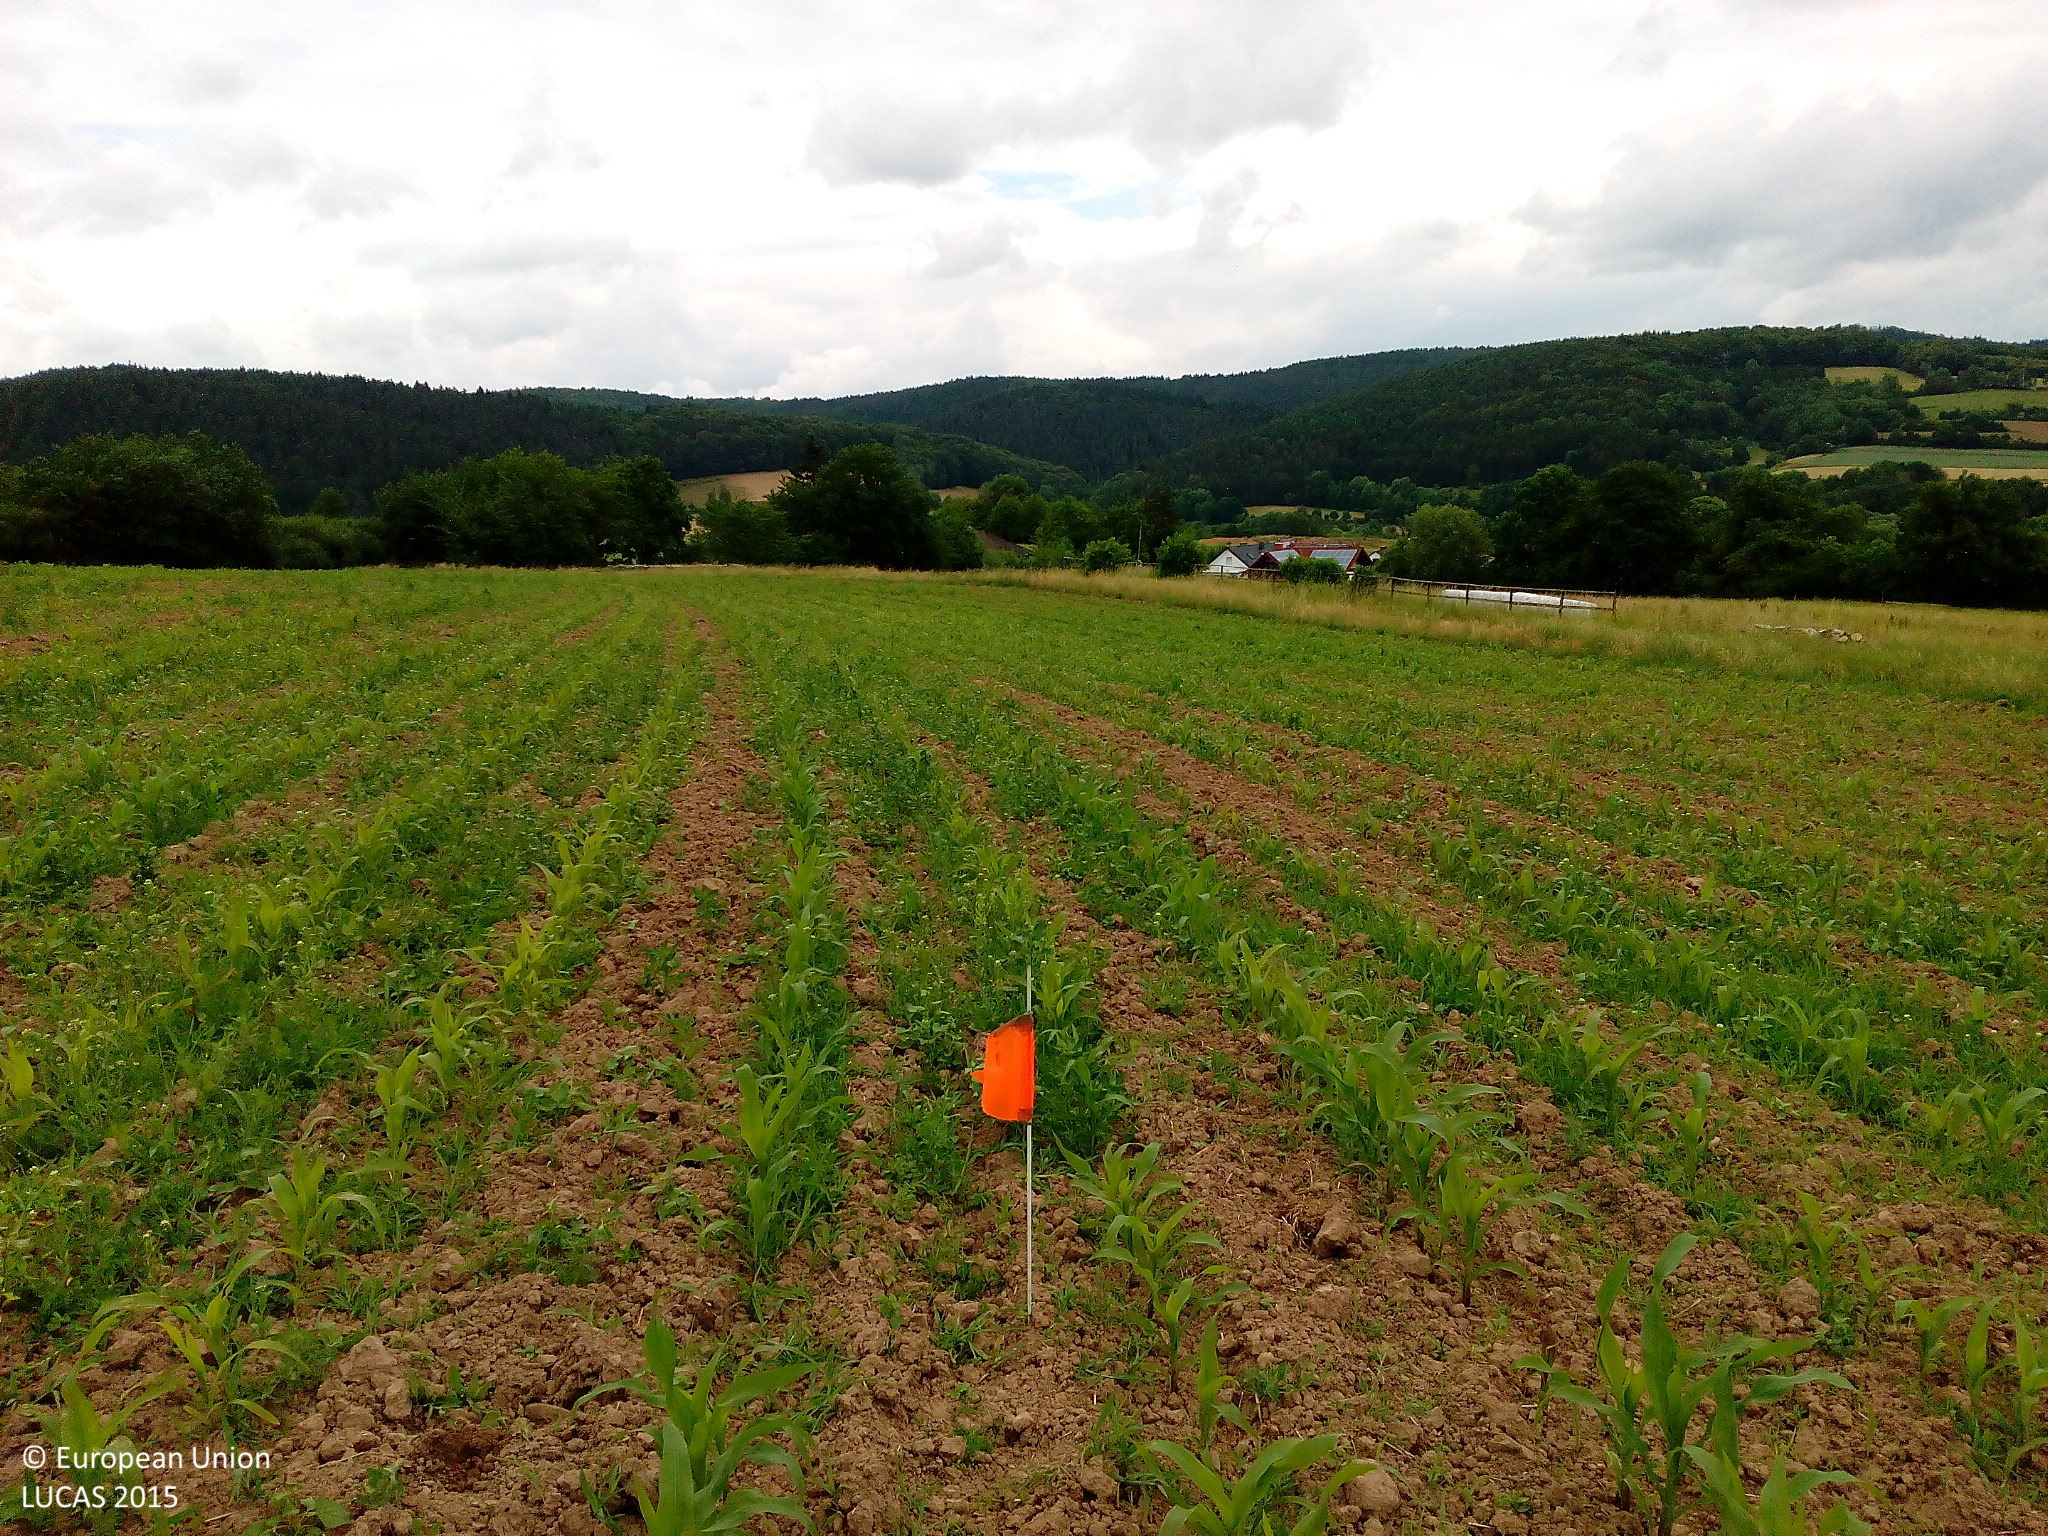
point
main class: Cropland
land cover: Maize
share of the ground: 25 - 50 %
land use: Agriculture (excluding fallow land and kitchen gardens)
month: June
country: DE
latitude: 50.9027
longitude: 9.5877
